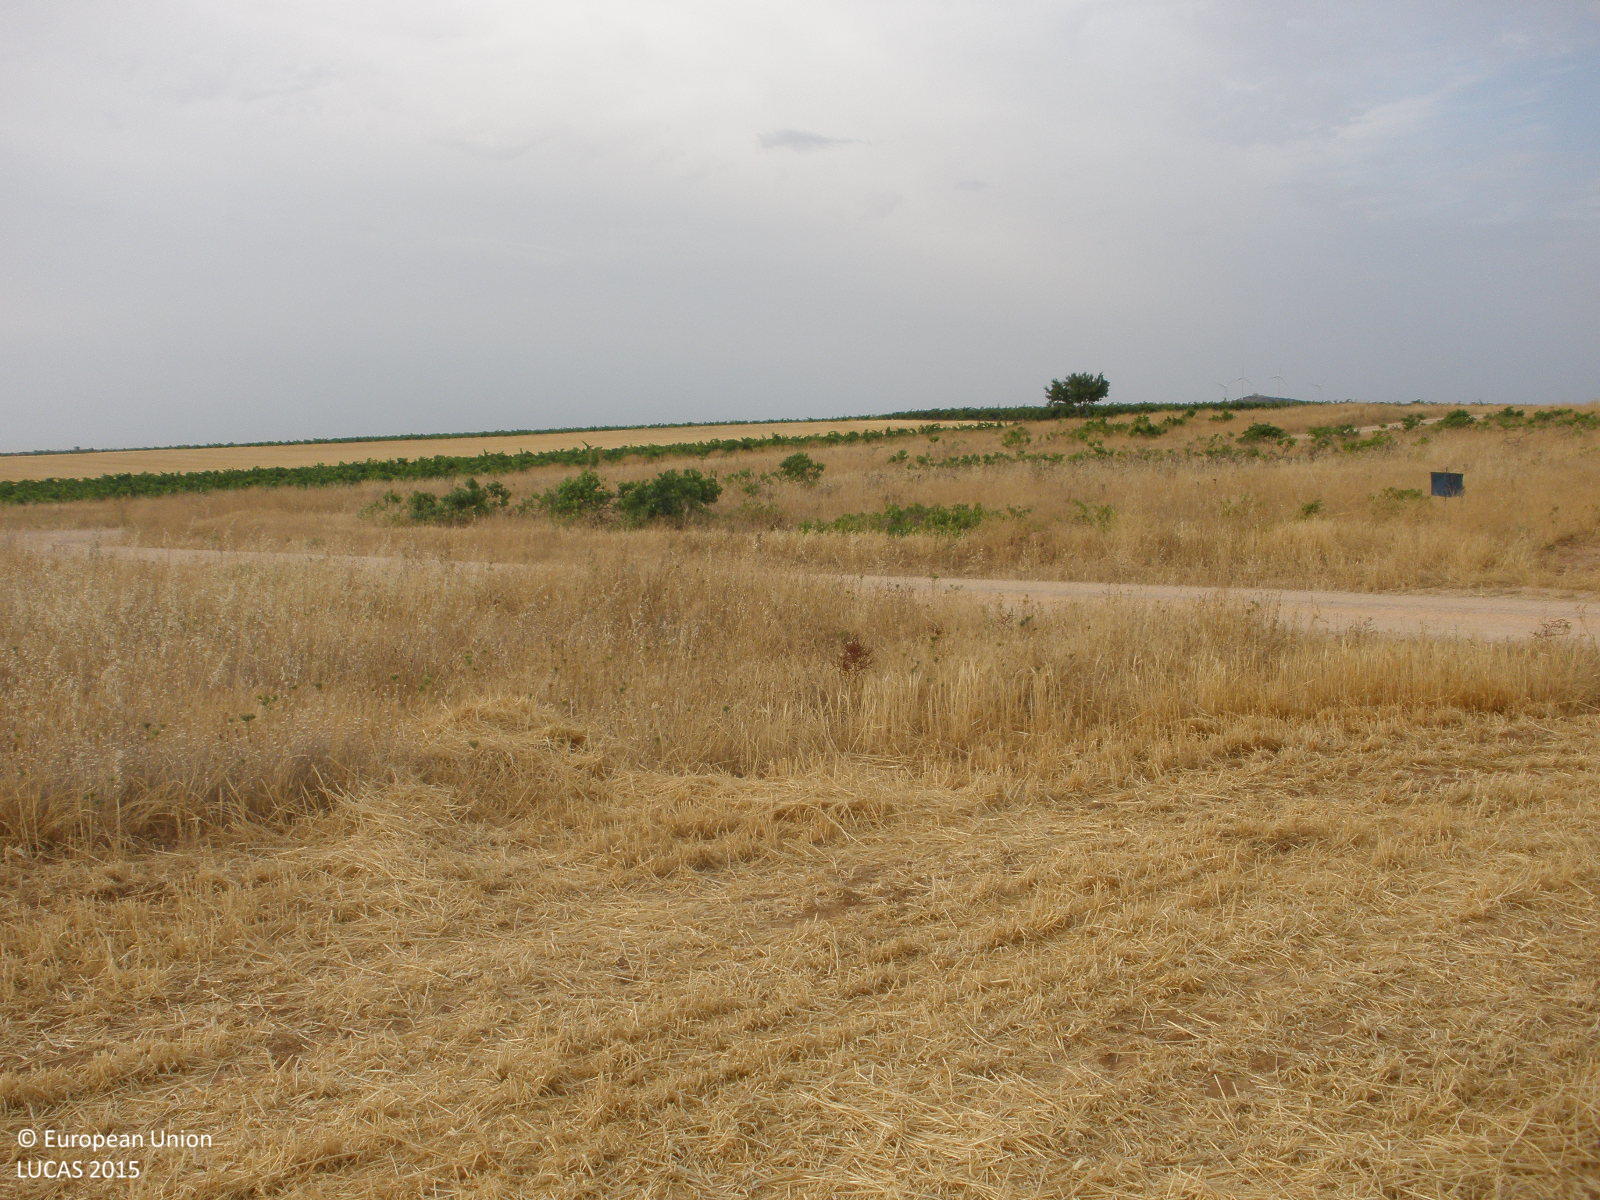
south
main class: Cropland
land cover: Barley
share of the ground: < 10 %
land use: Agriculture (excluding fallow land and kitchen gardens)
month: July
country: ES
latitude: 39.7996
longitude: -3.2801
